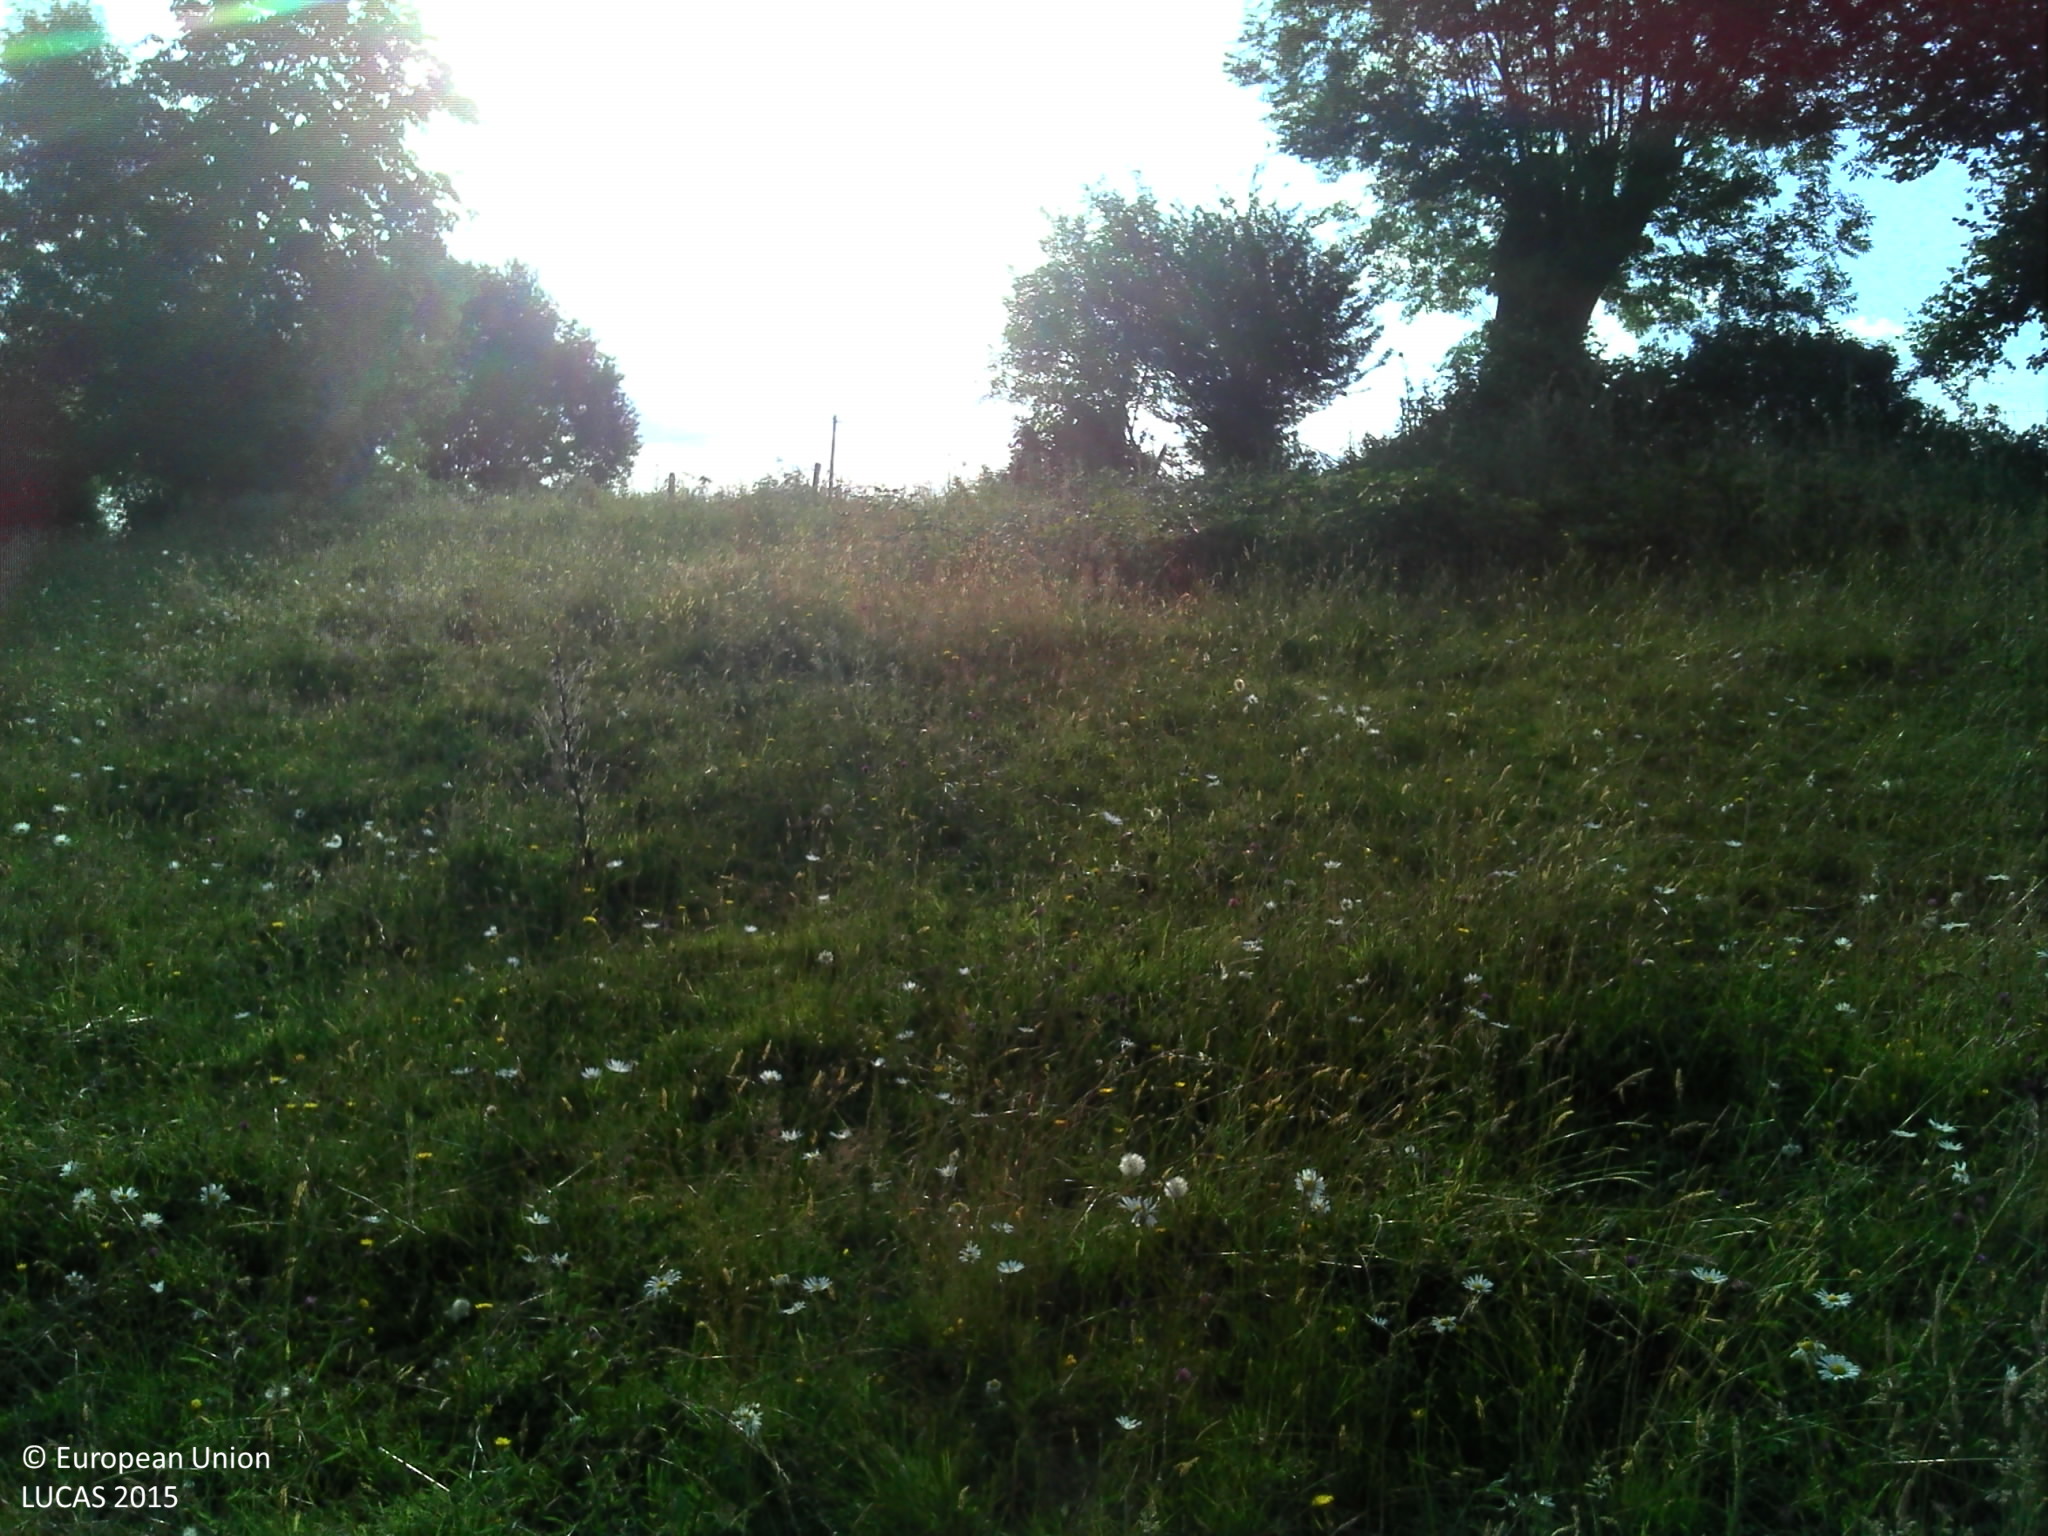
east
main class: Grassland
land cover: Grassland without tree/shrub cover
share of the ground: > 75 %
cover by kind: herbaceous plants 100 %
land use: Agriculture (excluding fallow land and kitchen gardens)
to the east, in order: Grassland without tree/shrub cover; Fences; Managed hedges; Grassland without tree/shrub cover; Fences; Grassland without tree/shrub cover; Fences; Broadleaved woodland; Fences; Grassland without tree/shrub cover
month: July
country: FR
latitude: 48.9903
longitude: 0.0895
